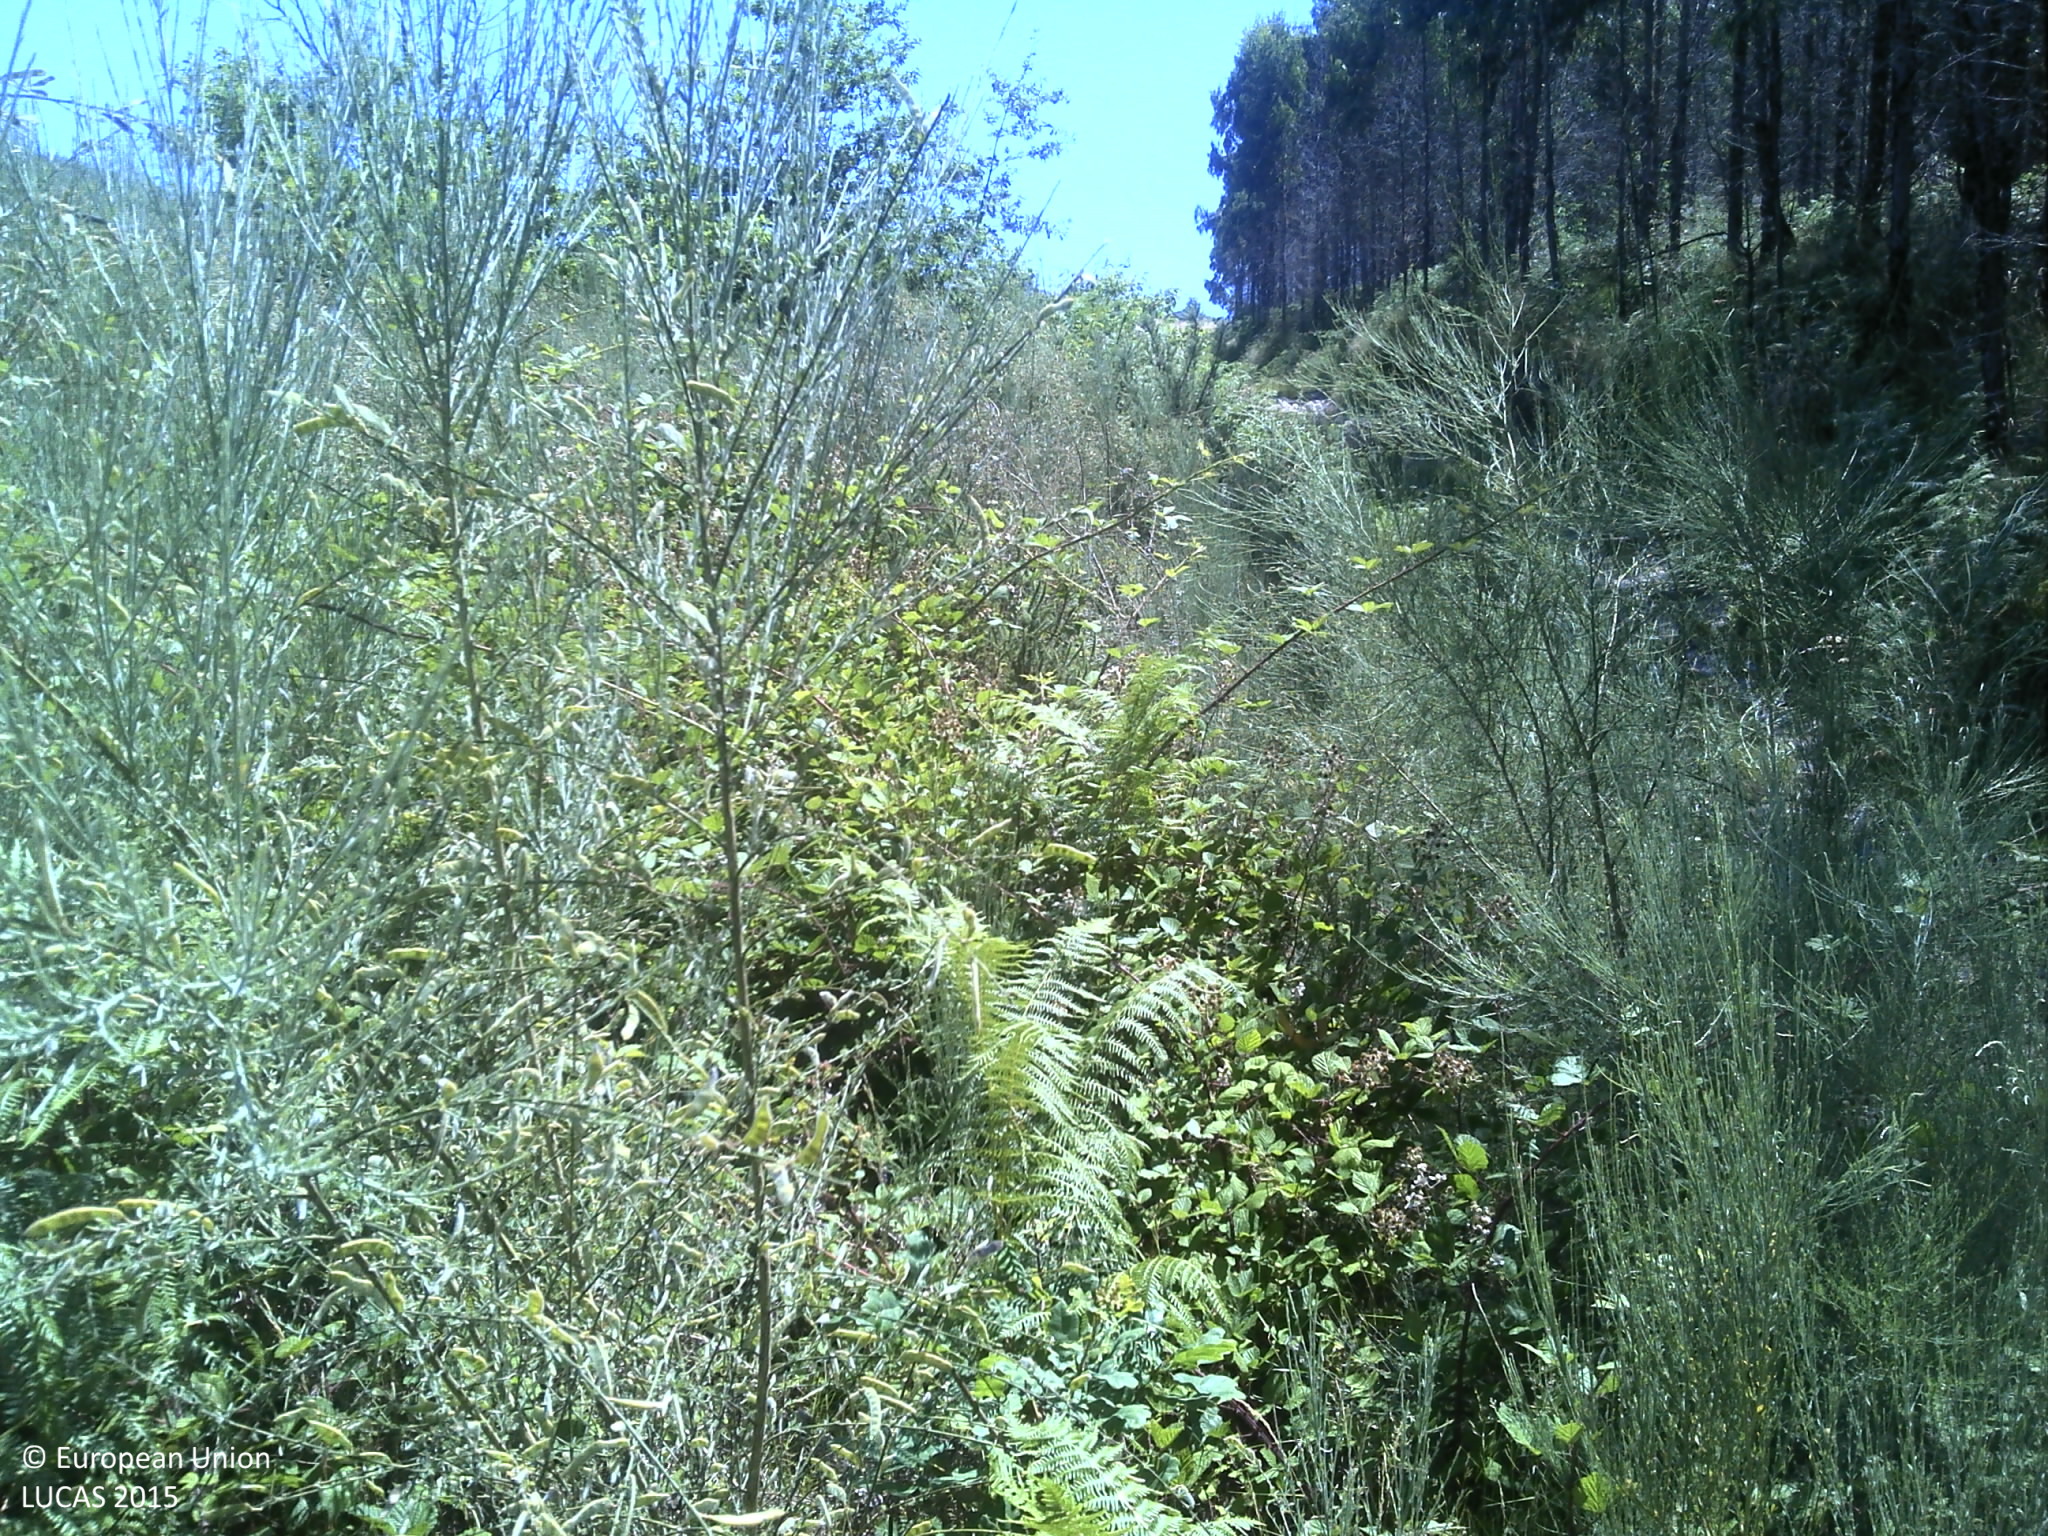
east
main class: Shrubland
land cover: Shrubland without tree cover
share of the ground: > 75 %
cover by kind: shrubs 85 %, unconsolidated bare surface 10 %, herbaceous plants 5 %
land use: Semi-natural and natural areas not in use
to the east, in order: Shrubland without tree cover; Rock outcrops; Shrubland without tree cover; Tracks; Rock outcrops; Shrubland without tree cover
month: June
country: PT
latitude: 41.4003
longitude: -8.0709
